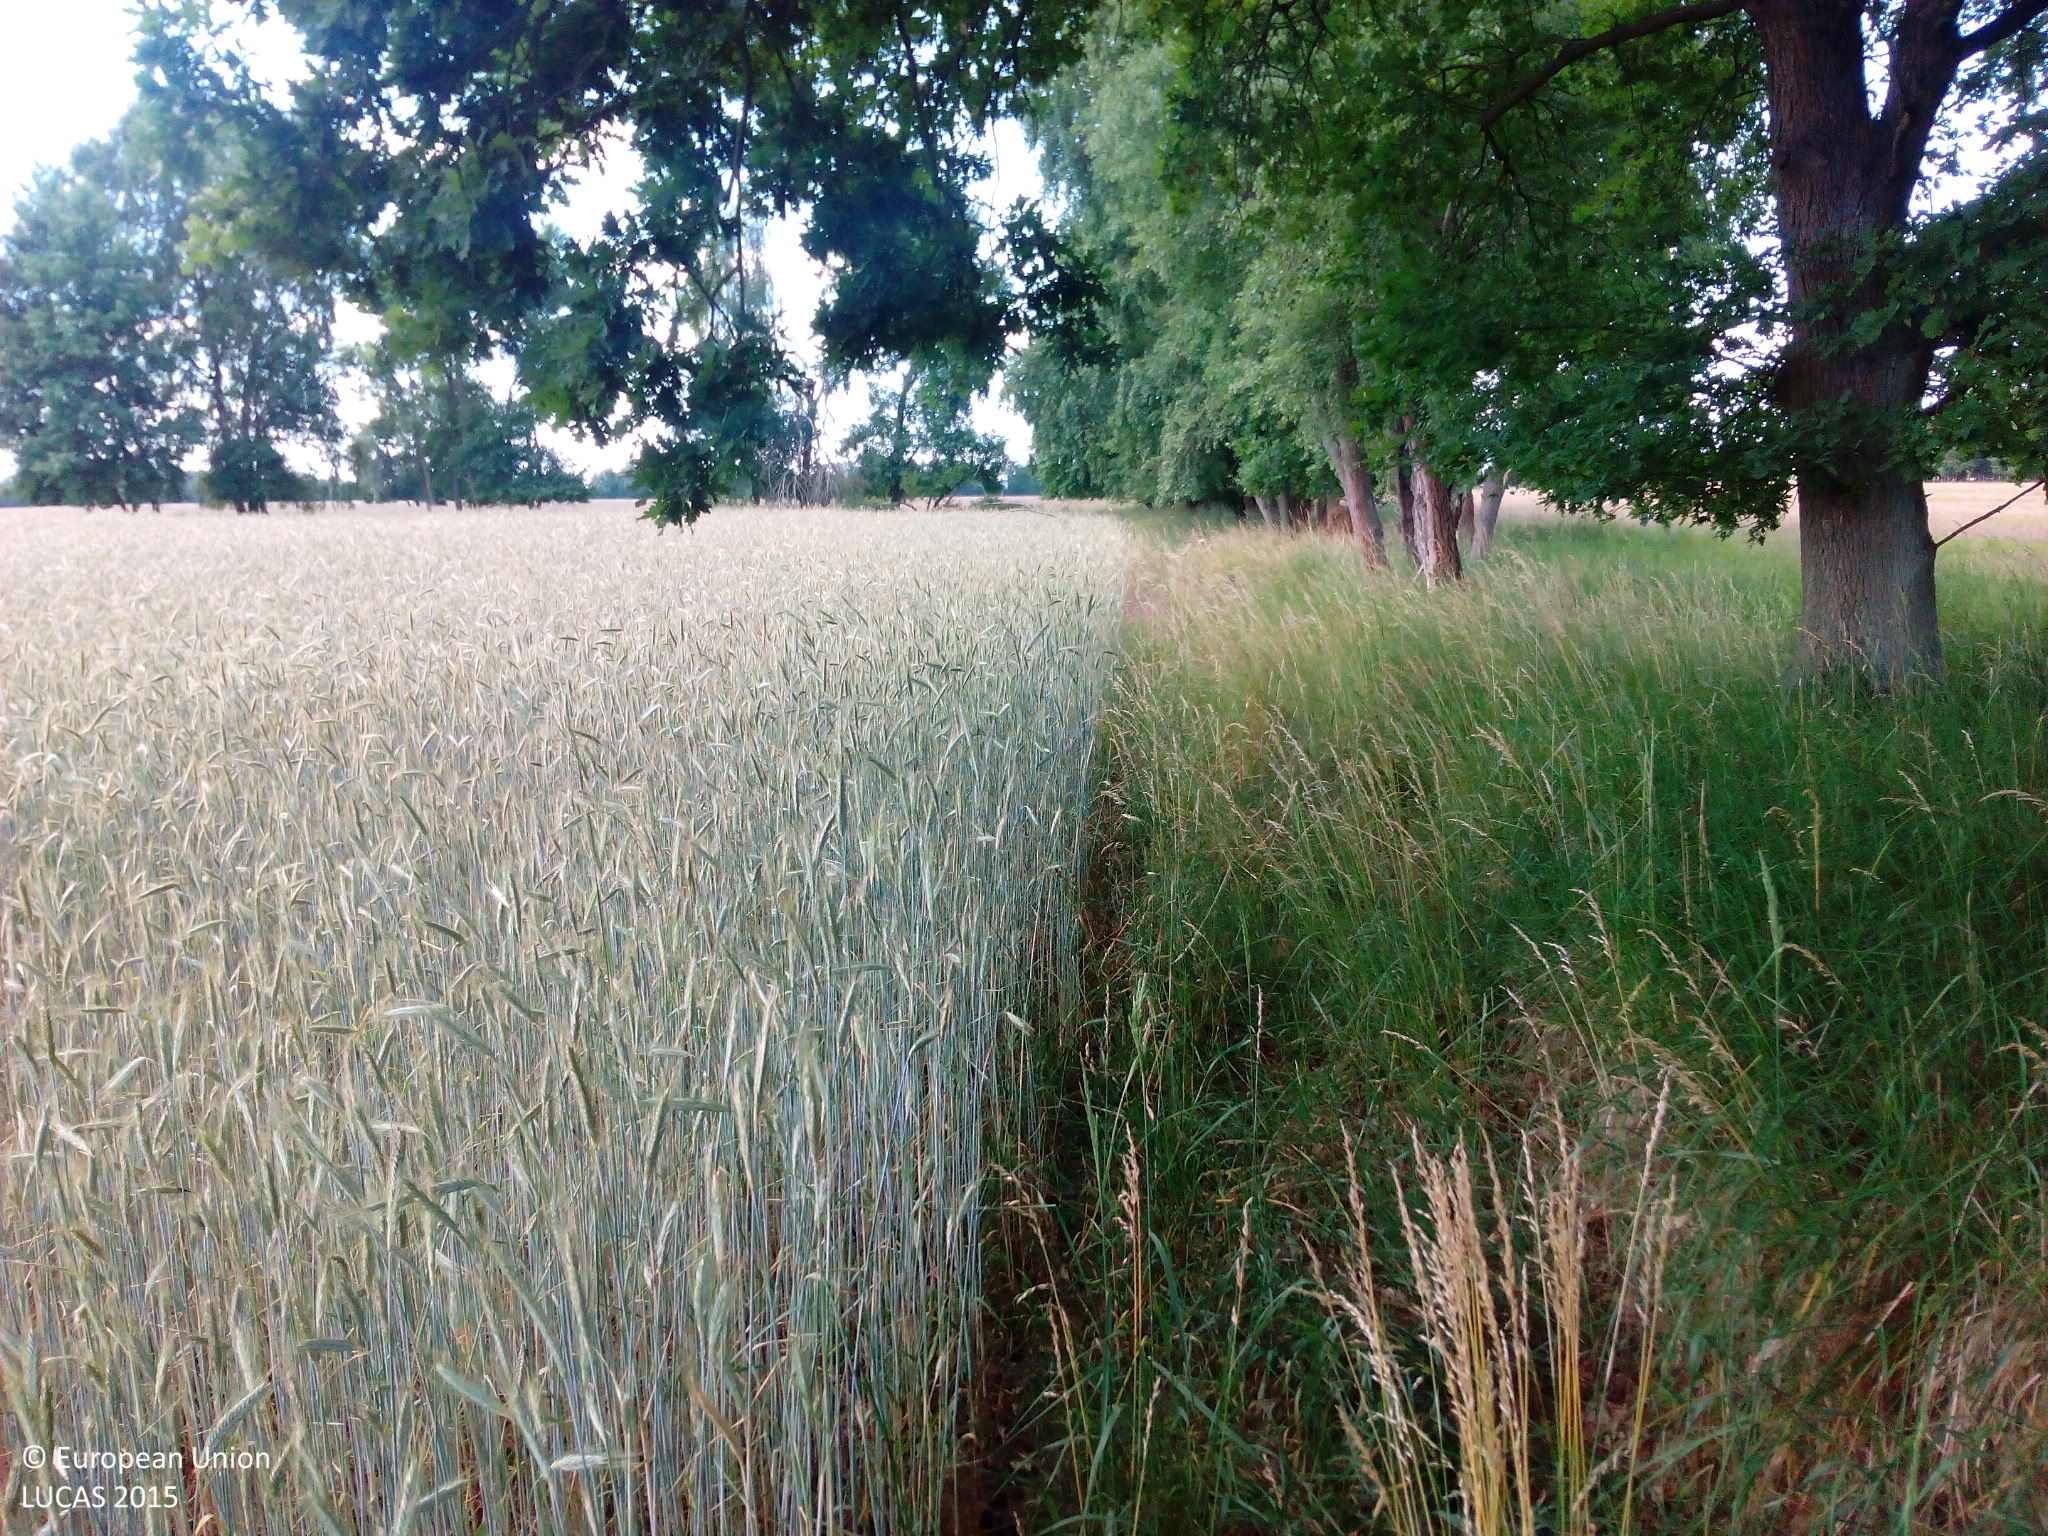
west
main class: Woodland
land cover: Broadleaved woodland
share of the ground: > 75 %
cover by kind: broadleaved forest trees 75 %, herbaceous plants 25 %
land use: Agriculture (excluding fallow land and kitchen gardens)
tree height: > 5 m
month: June
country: DE
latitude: 52.8211
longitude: 13.1606
